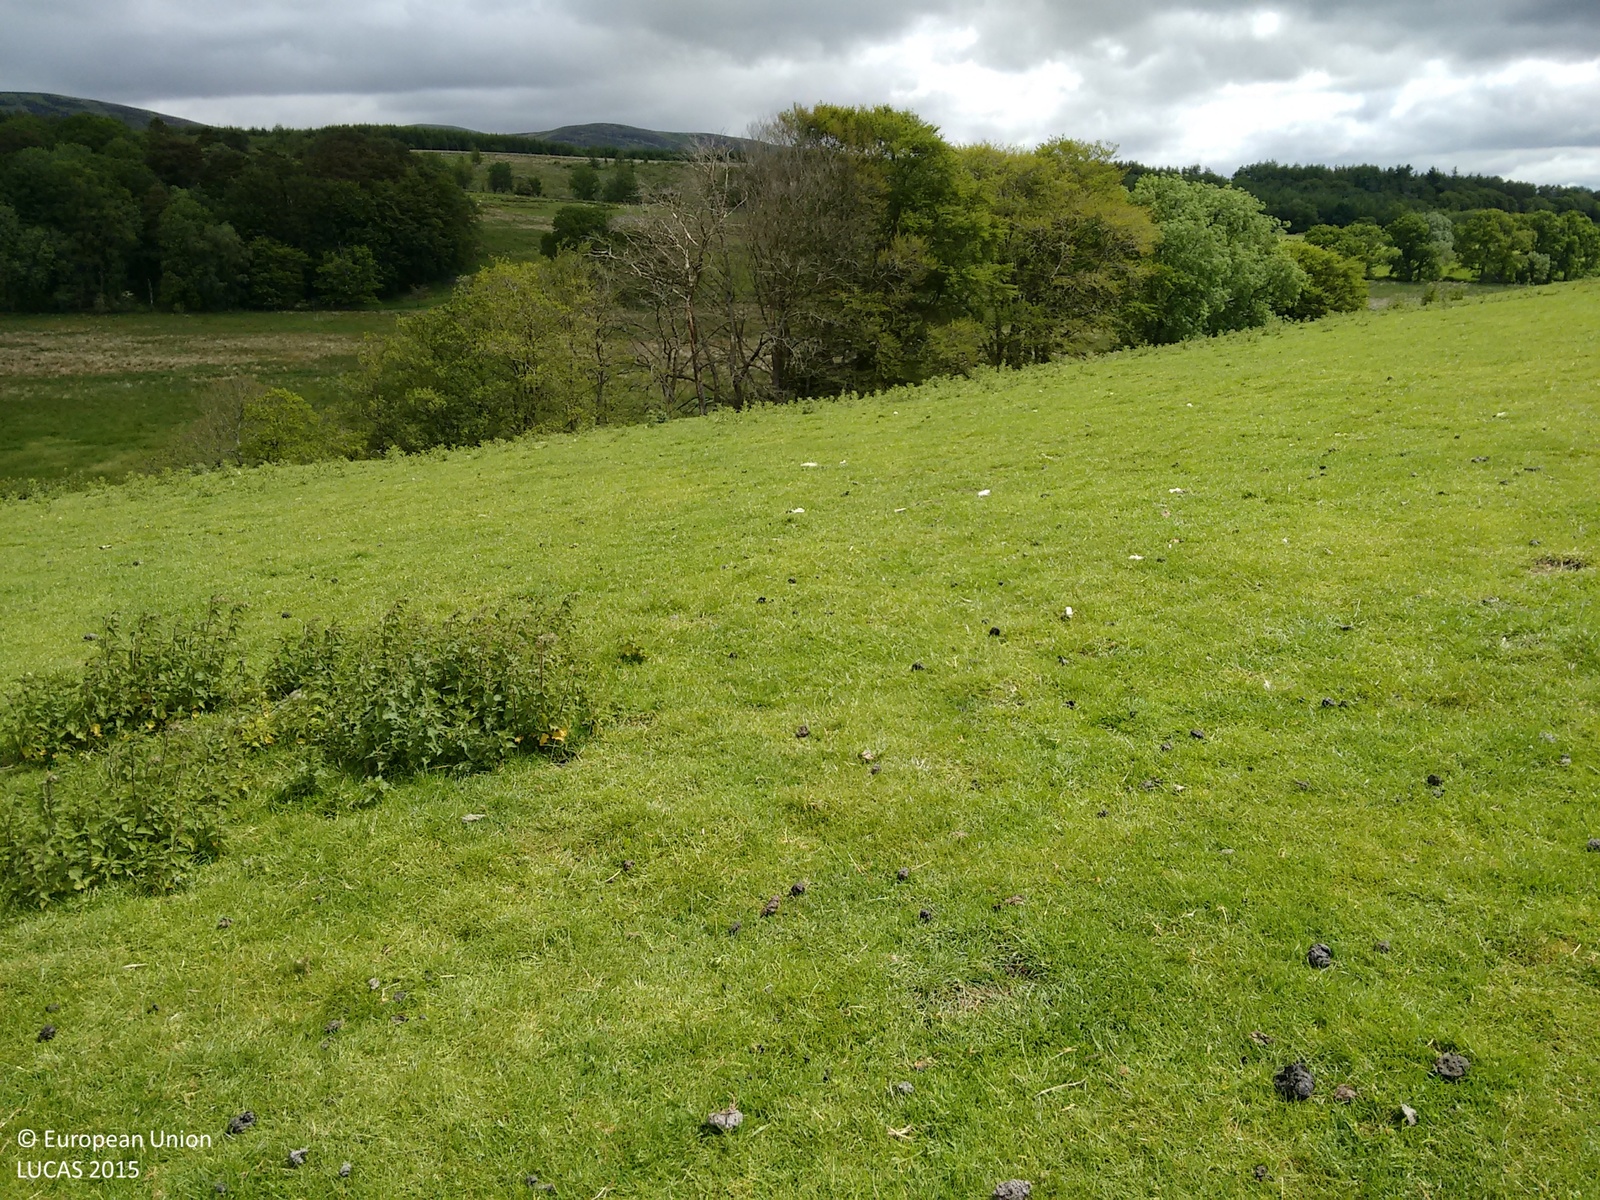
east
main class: Grassland
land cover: Grassland without tree/shrub cover
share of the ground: > 75 %
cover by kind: herbaceous plants 100 %
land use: Agriculture (excluding fallow land and kitchen gardens)
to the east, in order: Grassland without tree/shrub cover; Fences; Lines of trees; Grassland without tree/shrub cover; Grassland with sparse tree/shrub cover
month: June
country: GB
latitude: 55.2591
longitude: -3.7584
